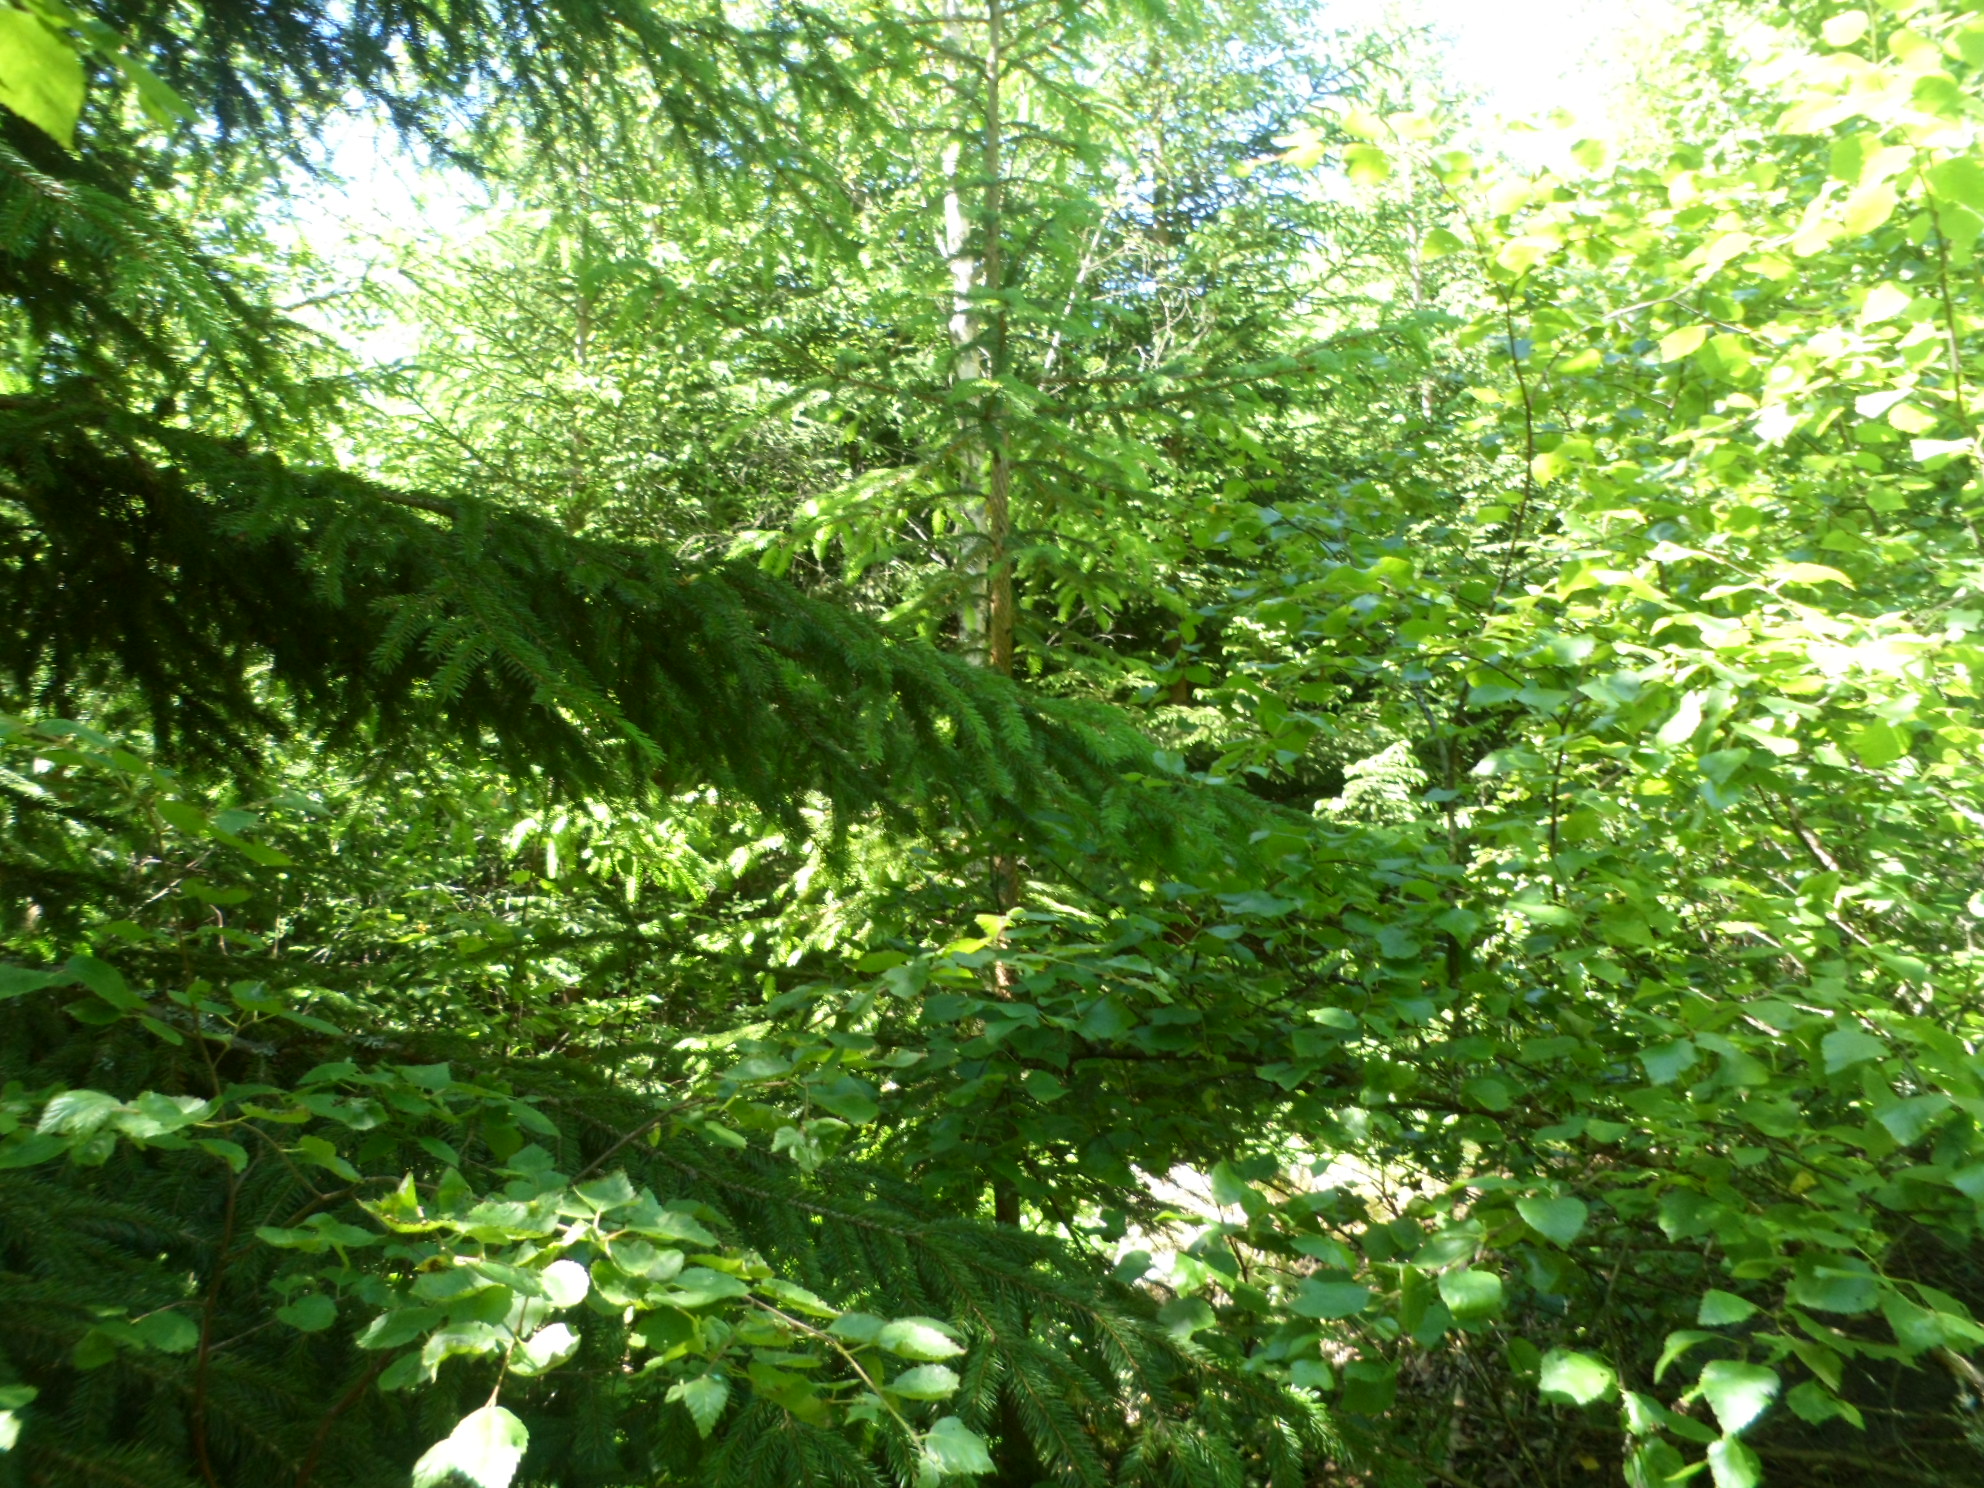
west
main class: Woodland
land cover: Spruce dominated mixed woodland
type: boreal forest
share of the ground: 50 - 75 %
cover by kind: coniferous forest trees 35 %, broadleaved forest trees 35 %, herbaceous plants 20 %, shrubs 5 %, lichens and mosses 5 %
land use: Forestry
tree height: > 5 m
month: July
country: SE
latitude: 57.1161
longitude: 14.5378
